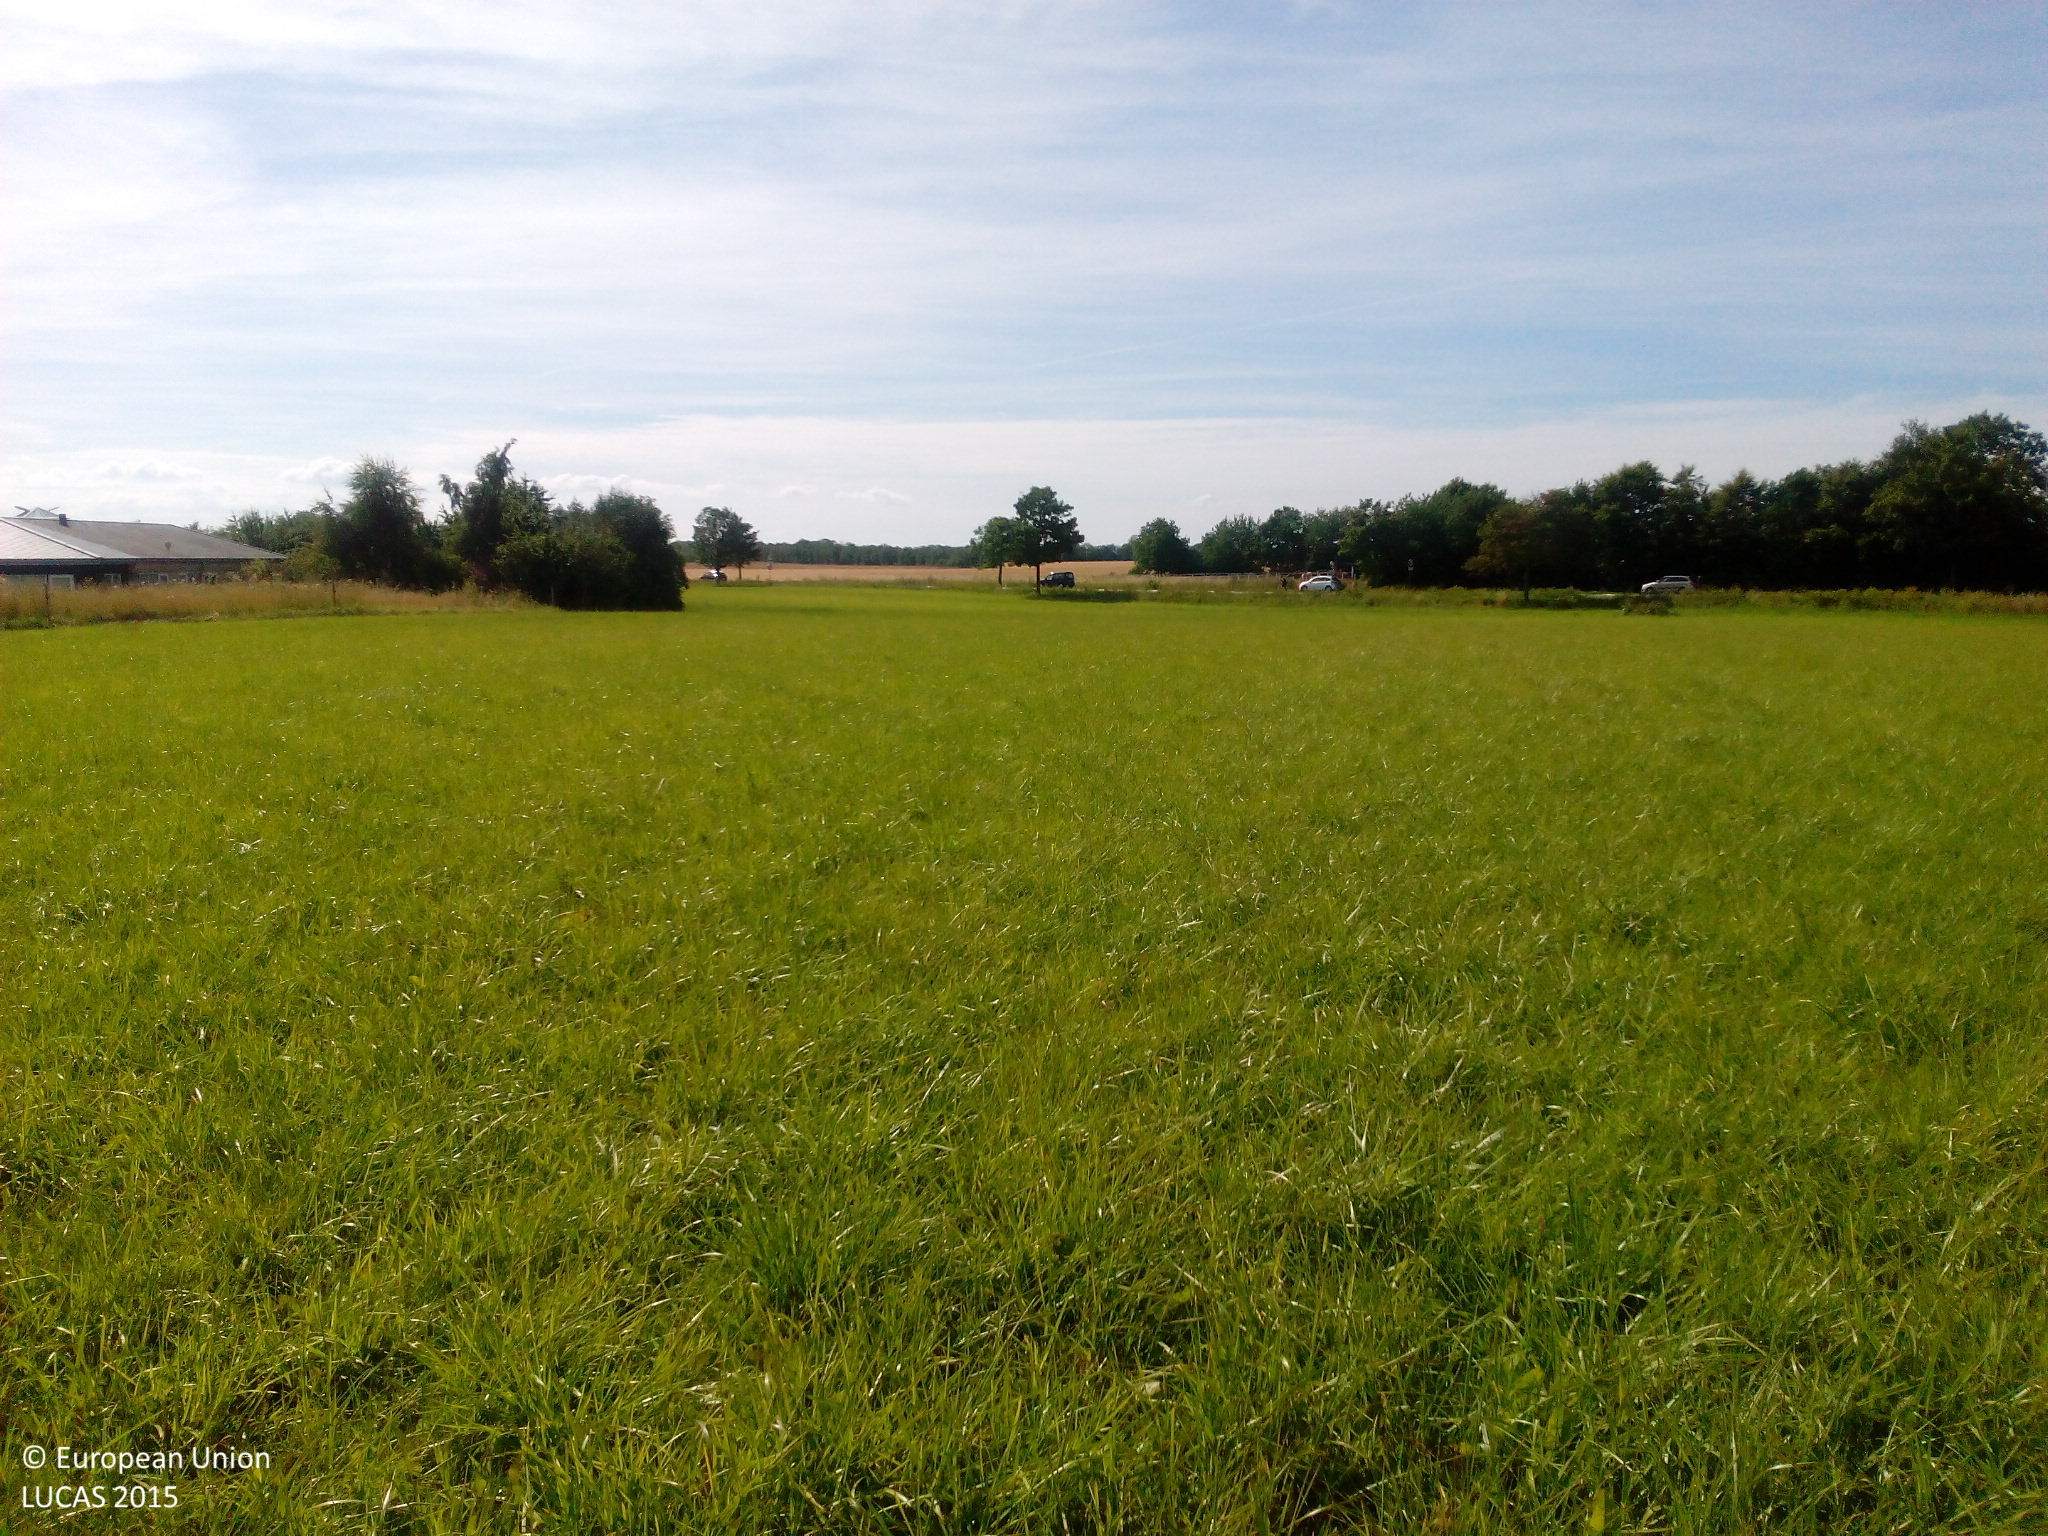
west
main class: Grassland
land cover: Grassland without tree/shrub cover
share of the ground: > 75 %
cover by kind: herbaceous plants 100 %
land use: Agriculture (excluding fallow land and kitchen gardens)
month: August
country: DK
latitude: 55.6140
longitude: 12.0464
